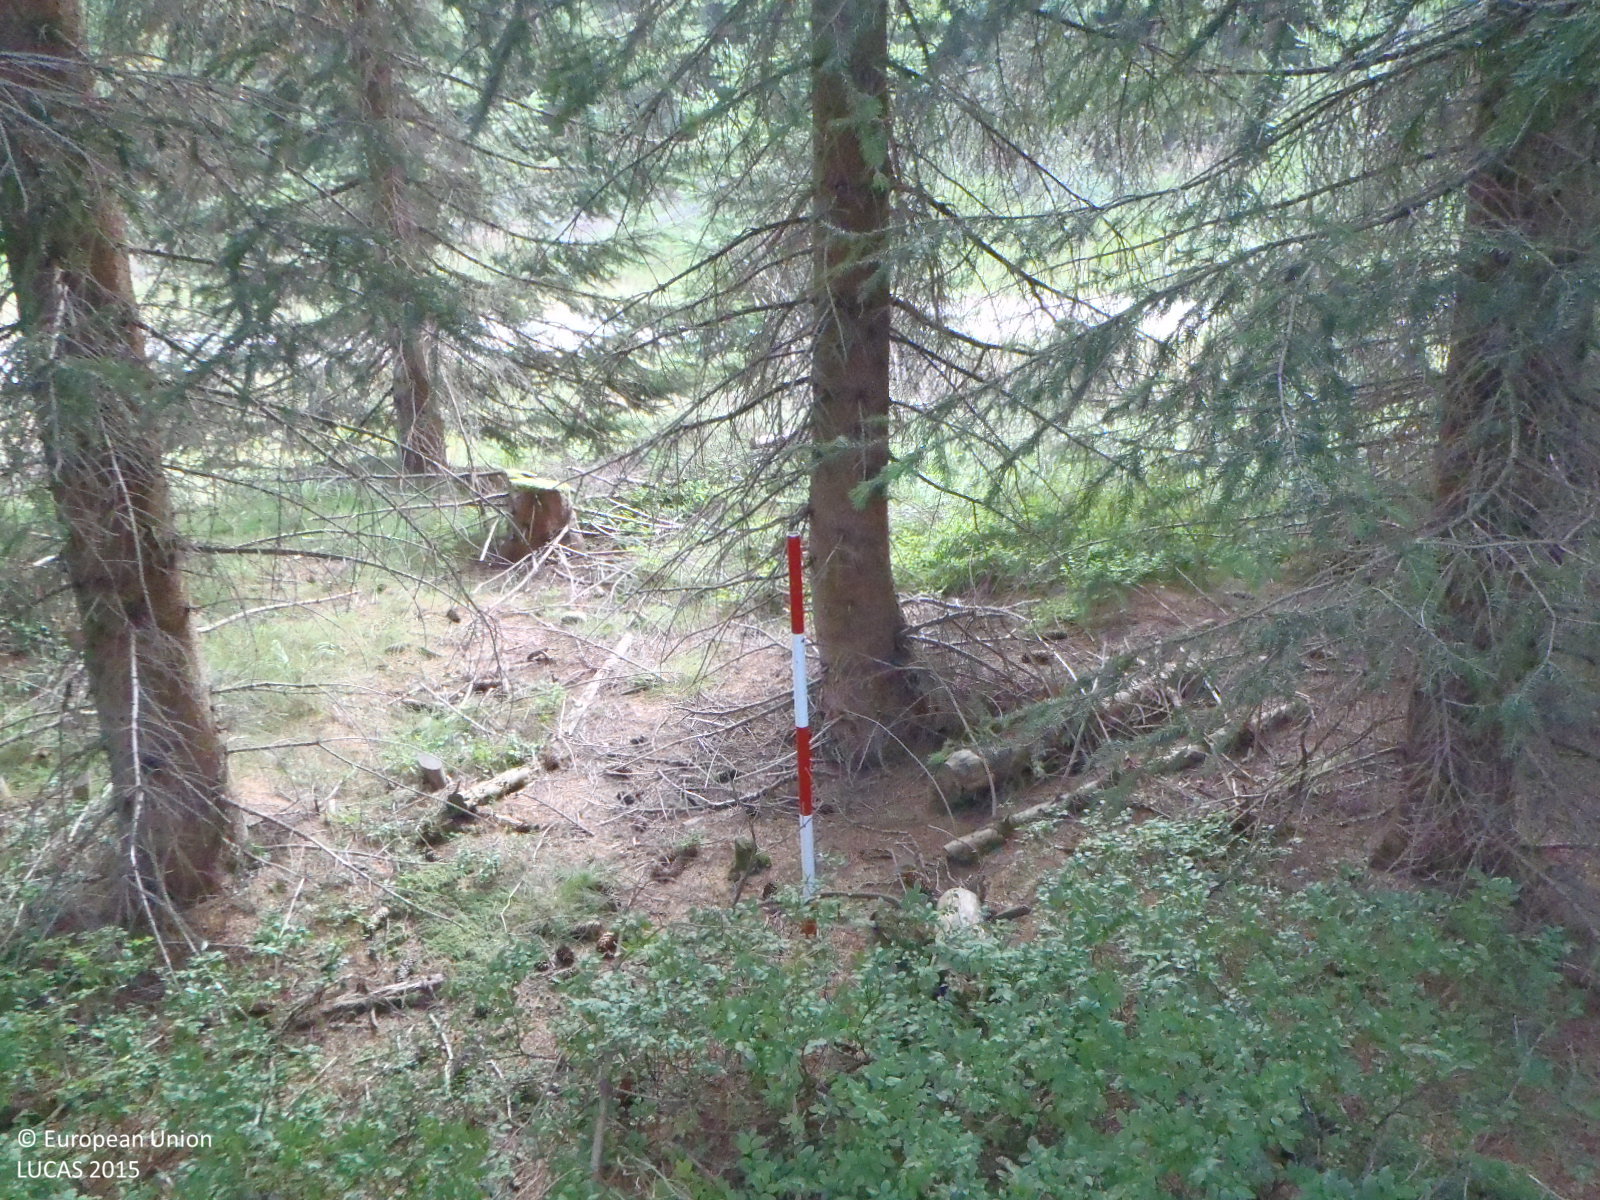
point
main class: Woodland
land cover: Spruce dominated coniferous woodland
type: hemiboreal forest and nemoral coniferous forest and mixed broadleaved-coniferous forest
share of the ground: > 75 %
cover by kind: coniferous forest trees 80 %, shrubs 10 %, herbaceous plants 10 %
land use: Forestry
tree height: > 5 m
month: August
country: CZ
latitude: 50.8551
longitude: 15.2738
